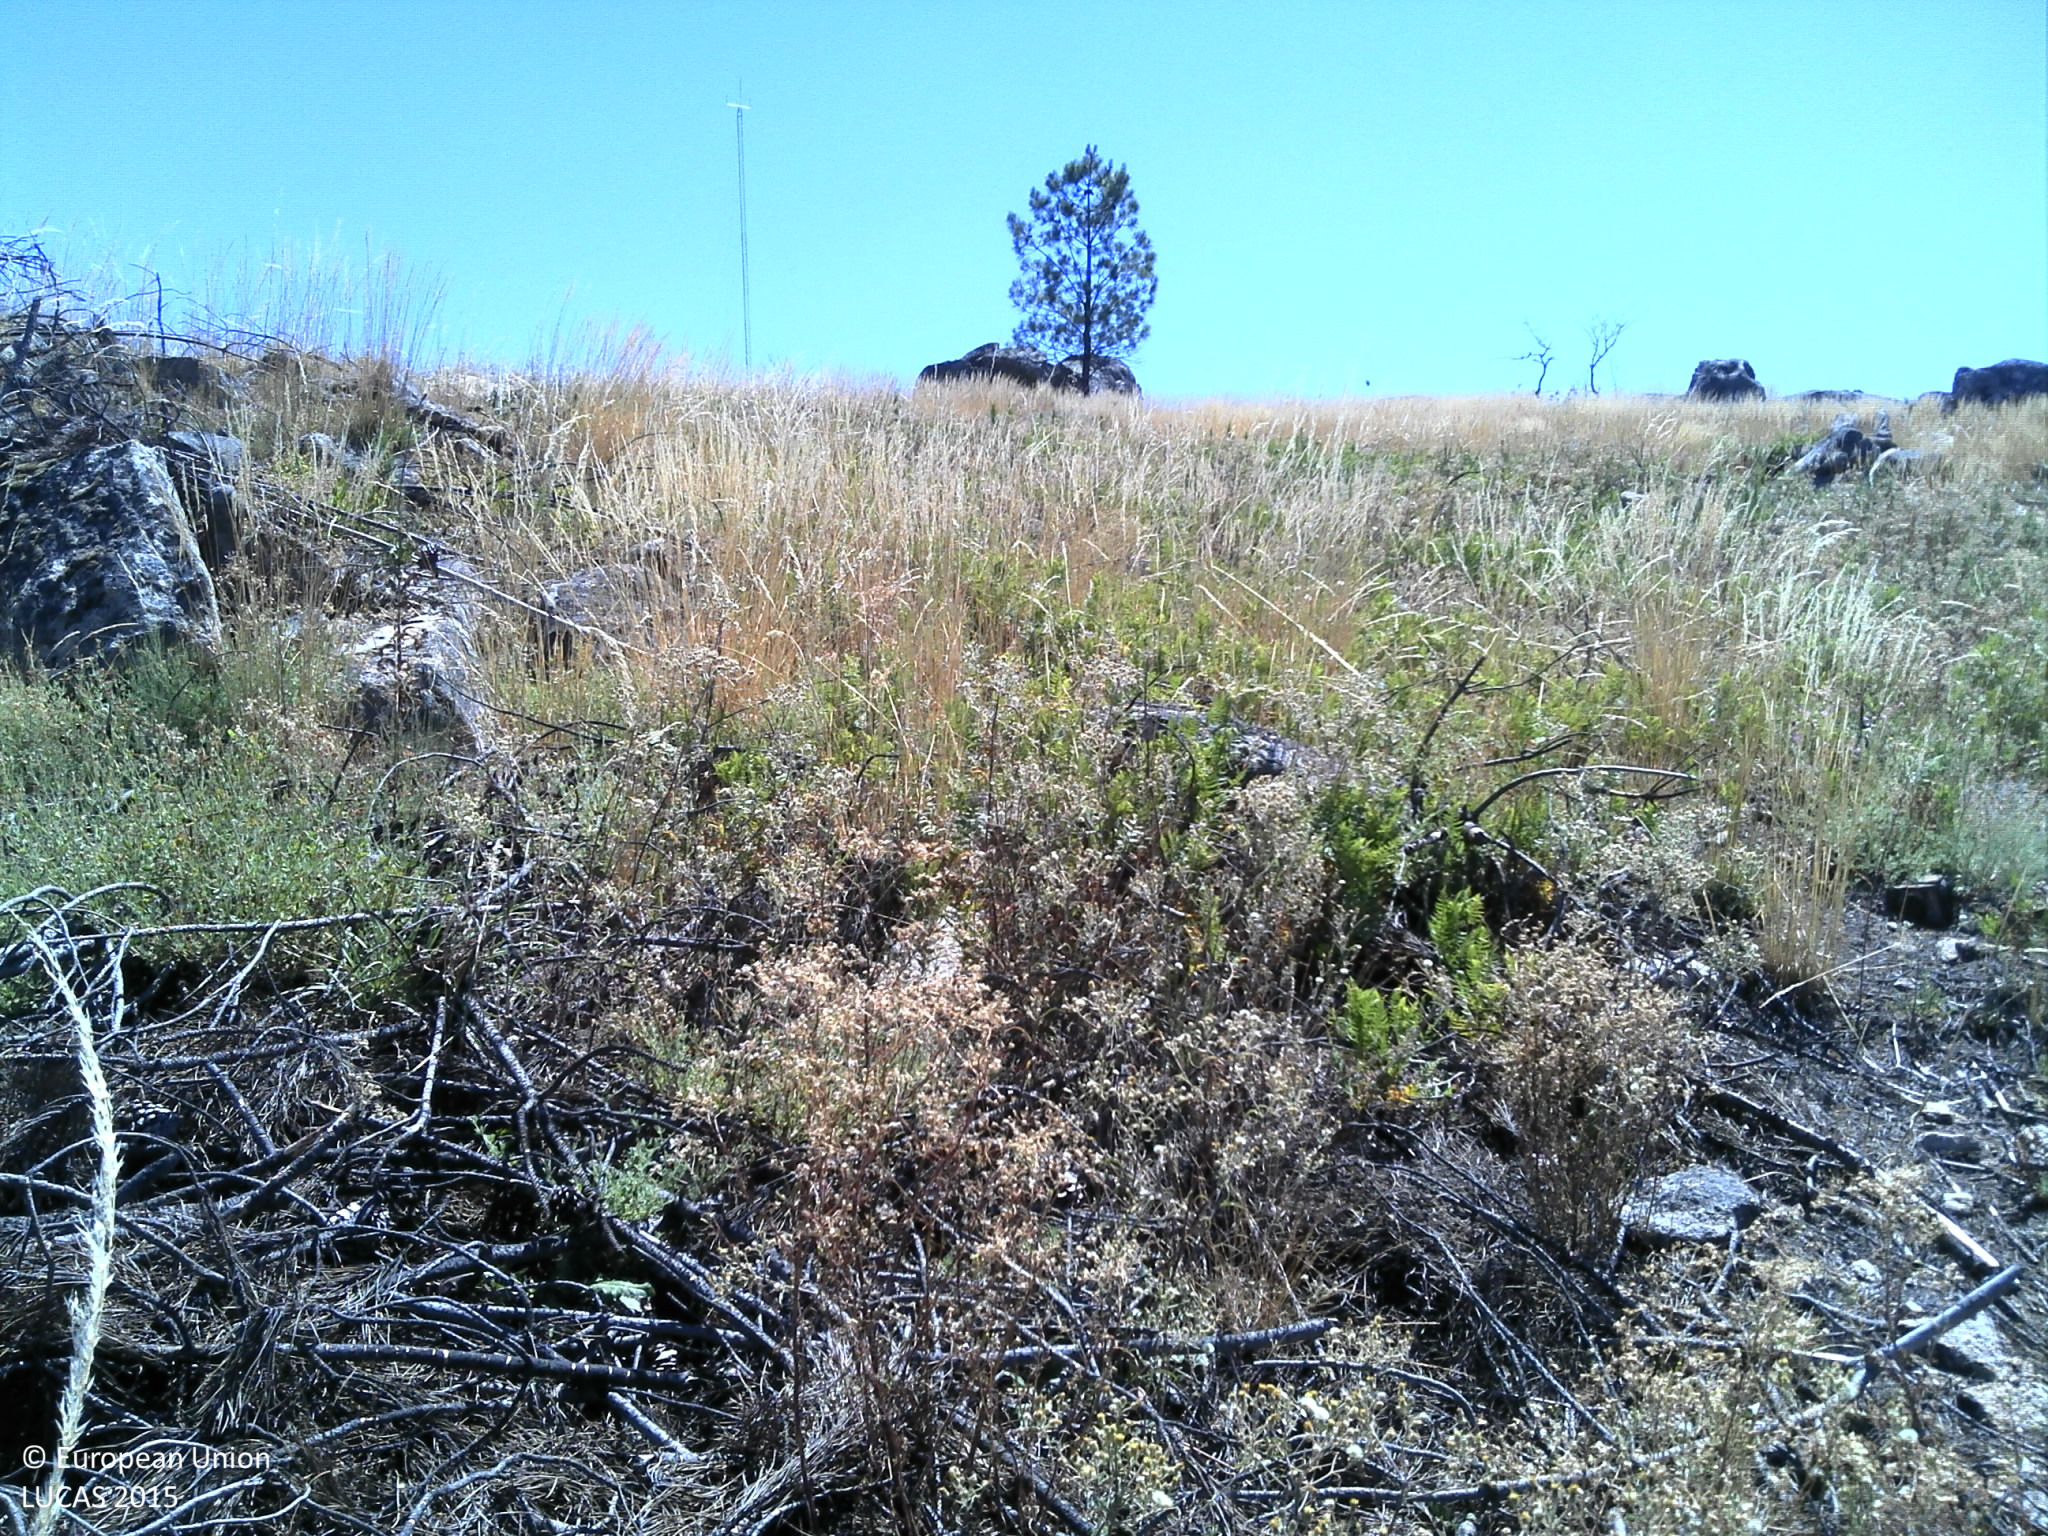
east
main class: Grassland
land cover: Spontaneously vegetated surfaces
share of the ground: > 75 %
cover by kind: herbaceous plants 95 %, unconsolidated bare surface 5 %
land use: Abandoned areas
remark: Burnt area
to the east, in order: Spontaneously vegetated surfaces; Rocks and stones; Spontaneously vegetated surfaces; Tracks; Single bushes/trees; Dry stone walls; Grassland with sparse tree/shrub cover; Spontaneously vegetated surfaces; Dry stone walls; Spontaneously vegetated surfaces; Grassland with sparse tree/shrub cover; Rock outcrops
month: June
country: PT
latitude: 40.7298
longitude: -7.2898
